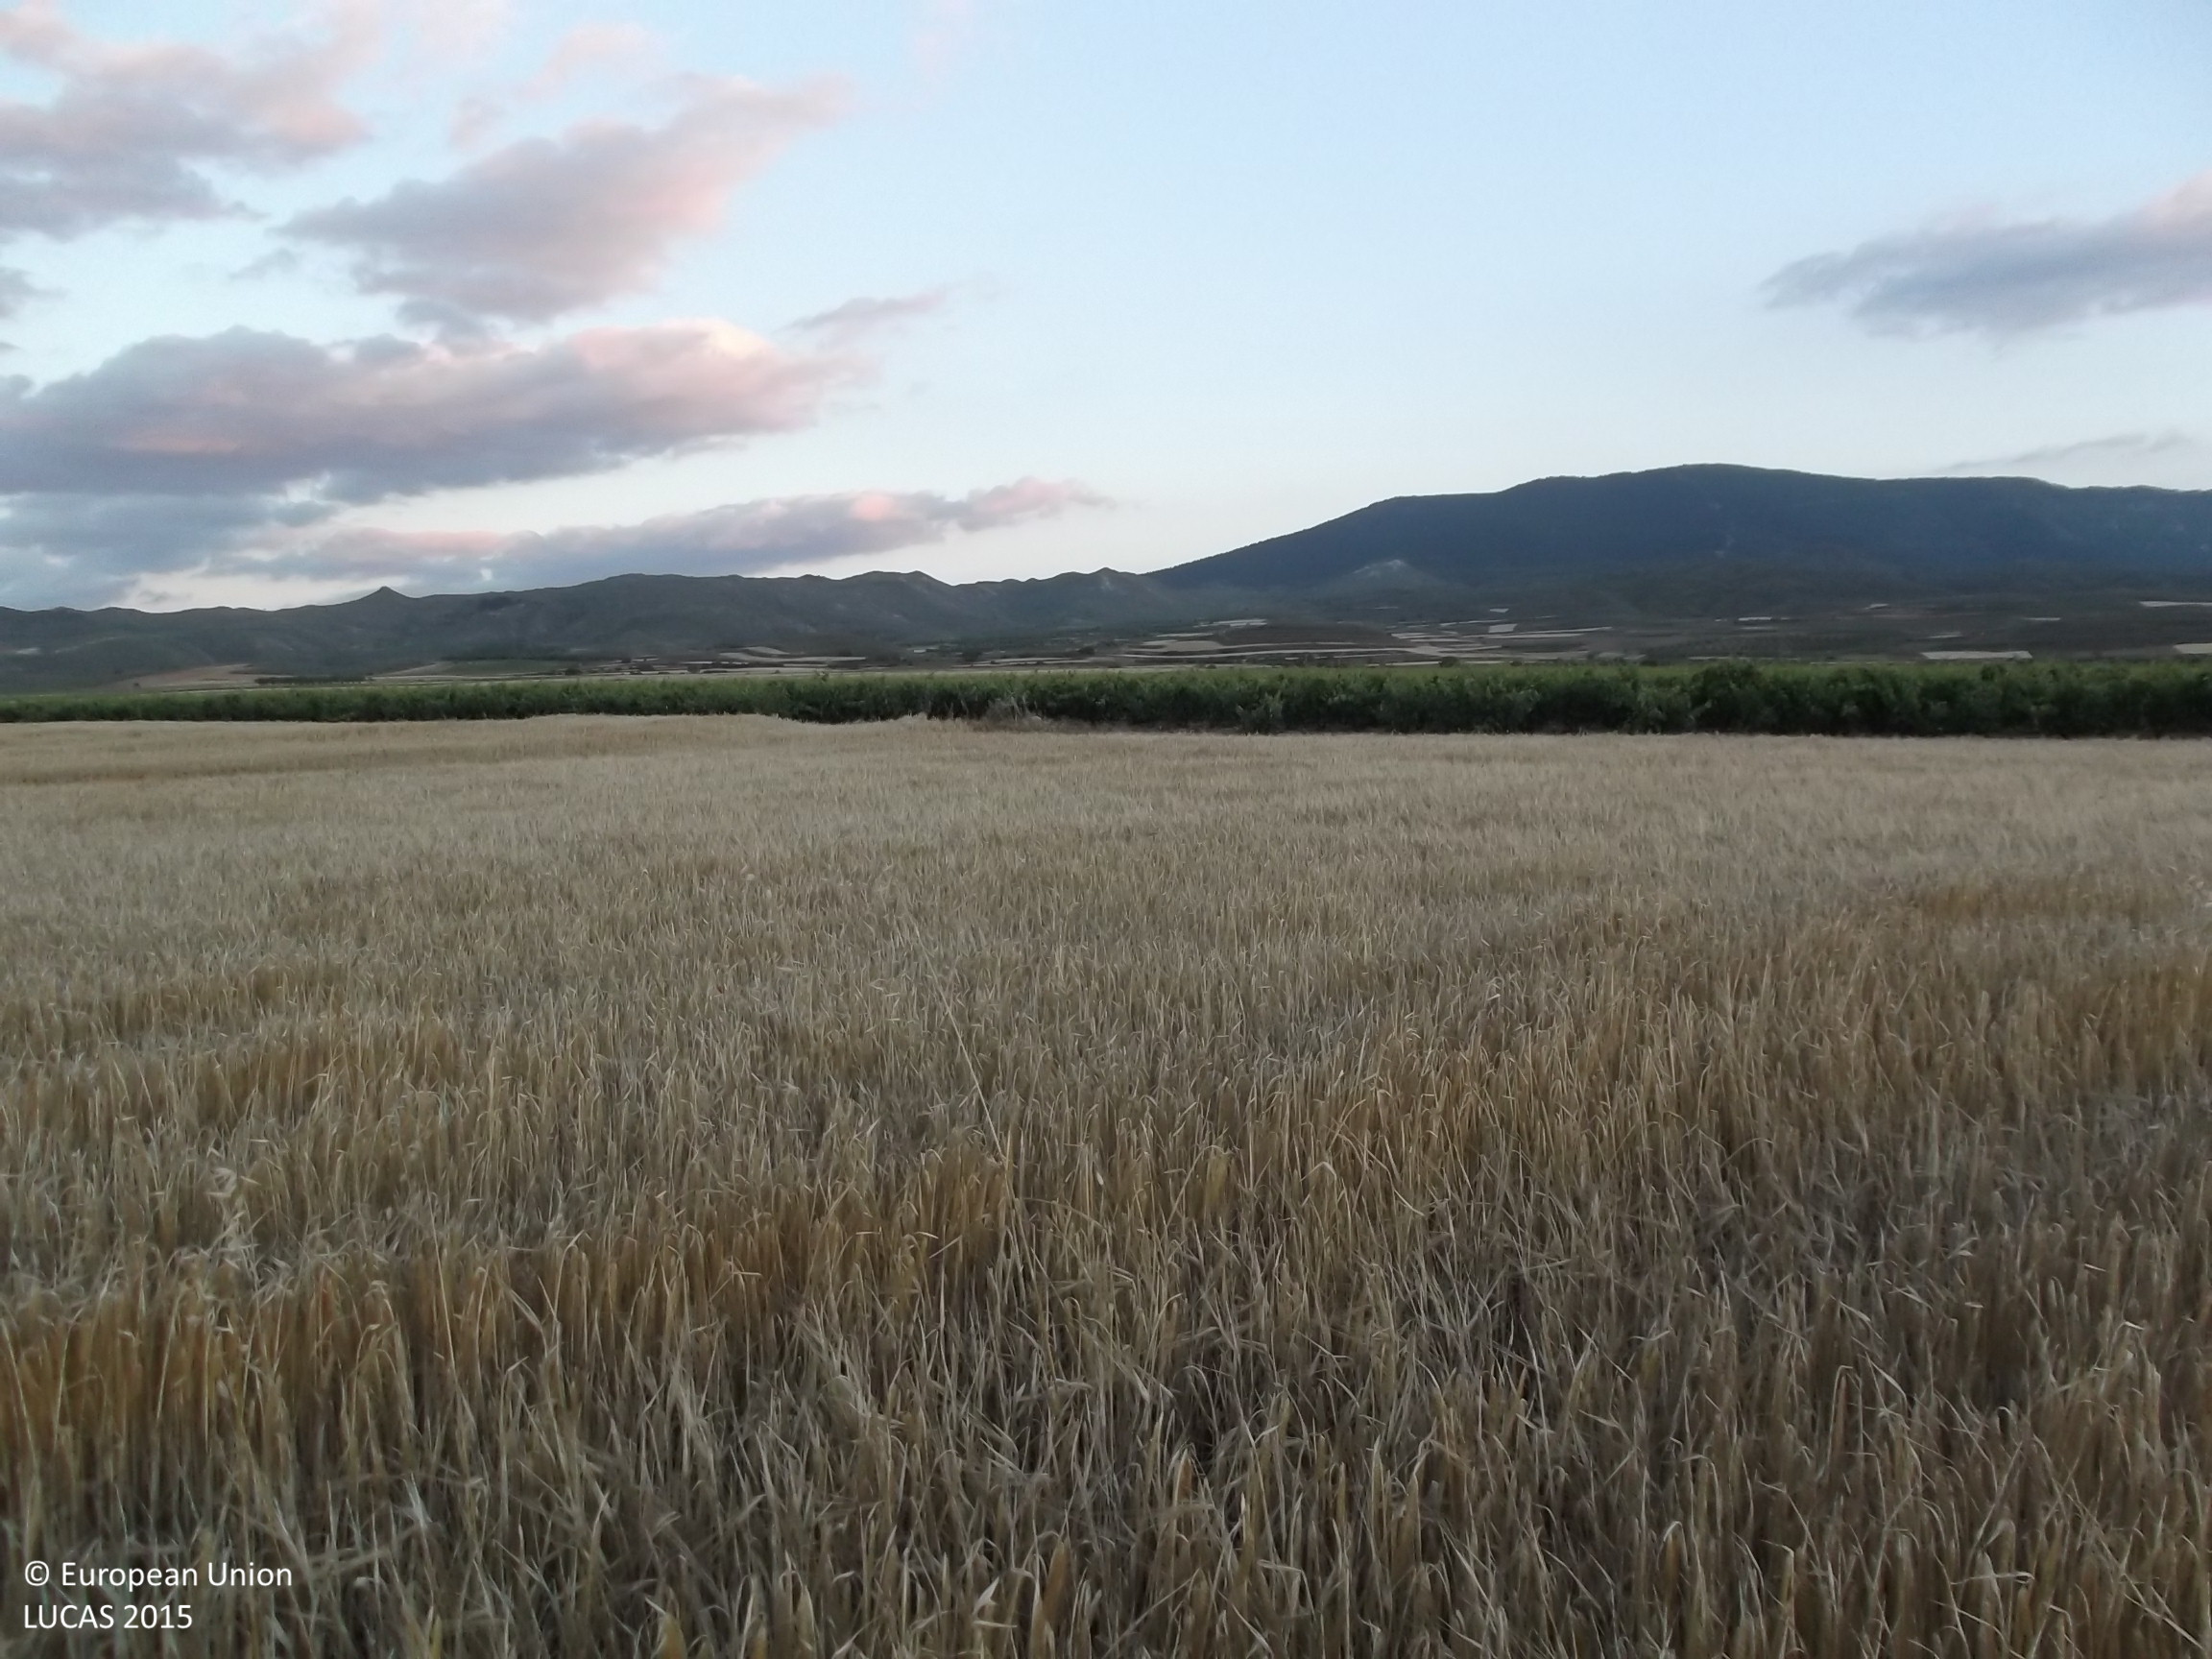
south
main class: Cropland
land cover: Barley
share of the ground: > 75 %
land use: Agriculture (excluding fallow land and kitchen gardens)
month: June
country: ES
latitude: 42.3703
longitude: -2.3440
